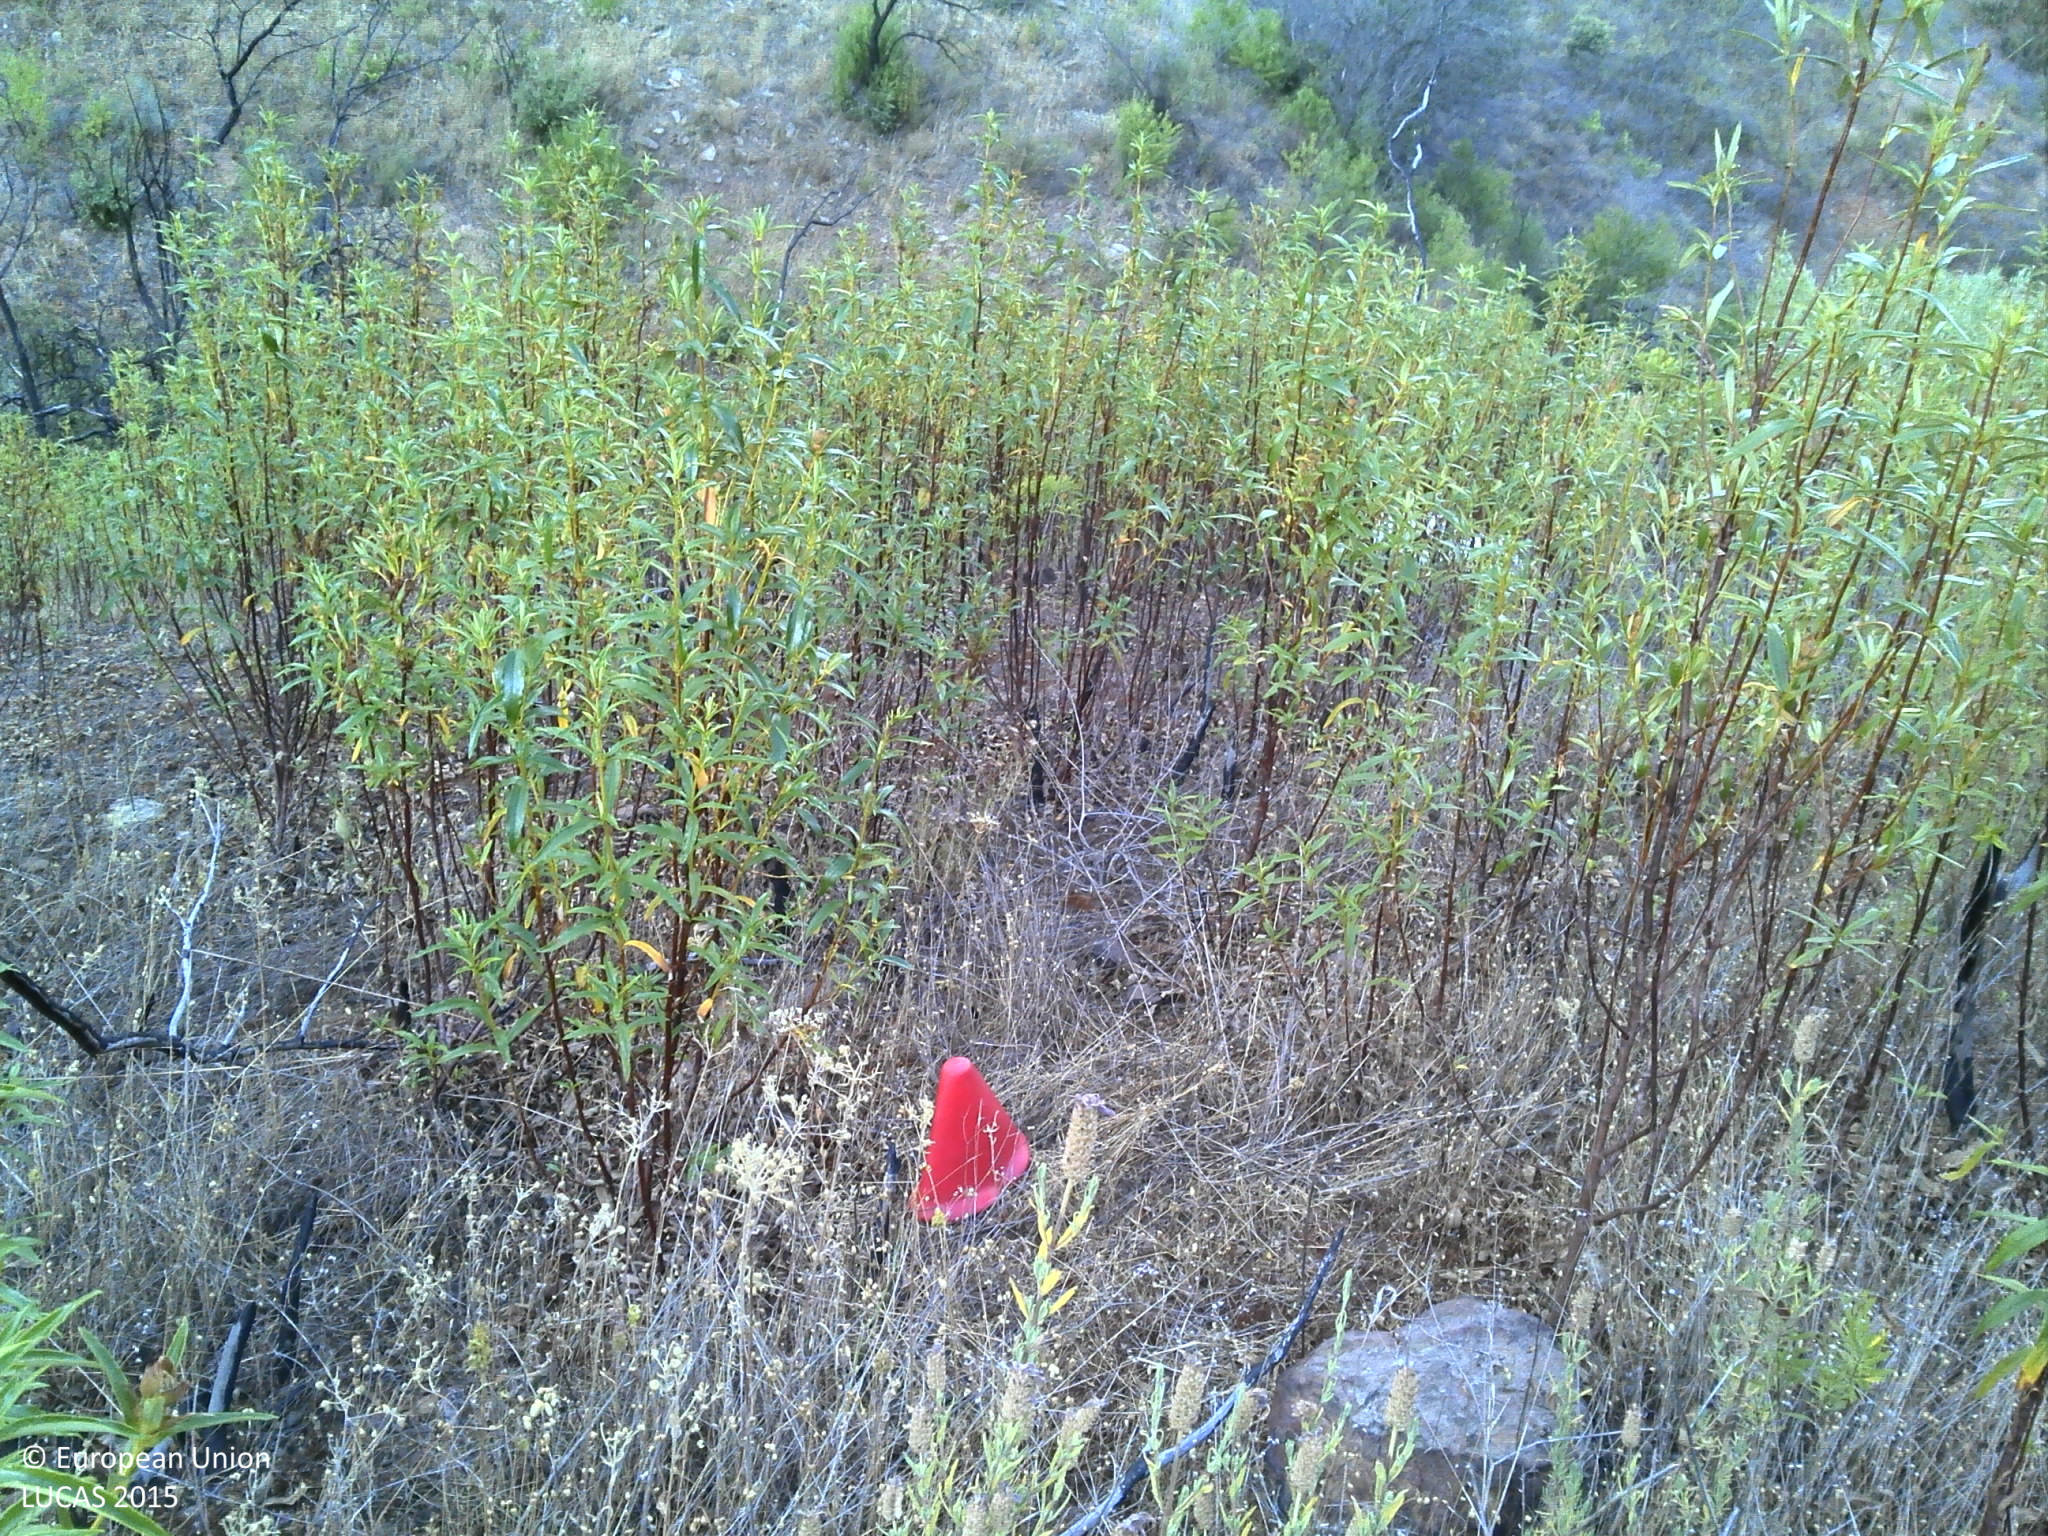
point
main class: Shrubland
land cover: Shrubland without tree cover
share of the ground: 50 - 75 %
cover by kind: shrubs 90 %, herbaceous plants 5 %, unconsolidated bare surface 5 %
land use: Abandoned areas
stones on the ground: < 10 %
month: June
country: PT
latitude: 37.2396
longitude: -7.6946
